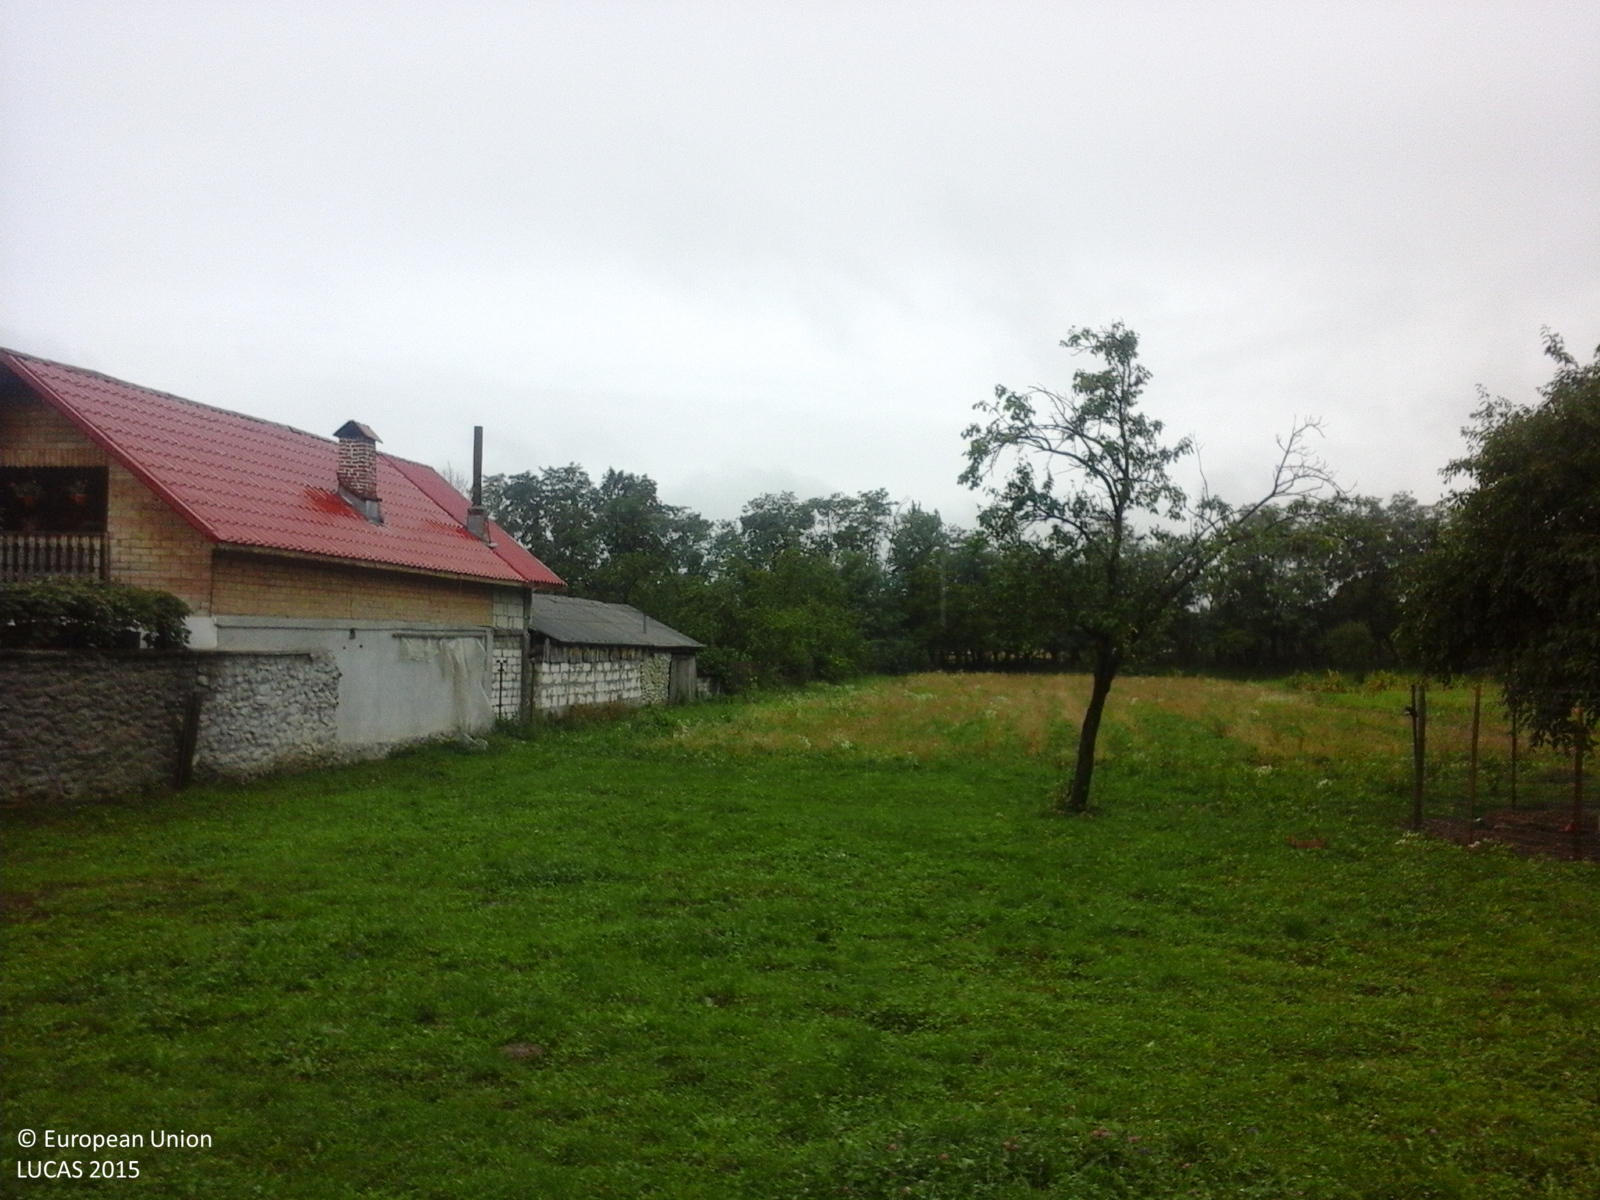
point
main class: Grassland
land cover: Spontaneously vegetated surfaces
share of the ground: > 75 %
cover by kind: herbaceous plants 100 %
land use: Agriculture (excluding fallow land and kitchen gardens)
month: September
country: RO
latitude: 45.1783
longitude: 23.7944
